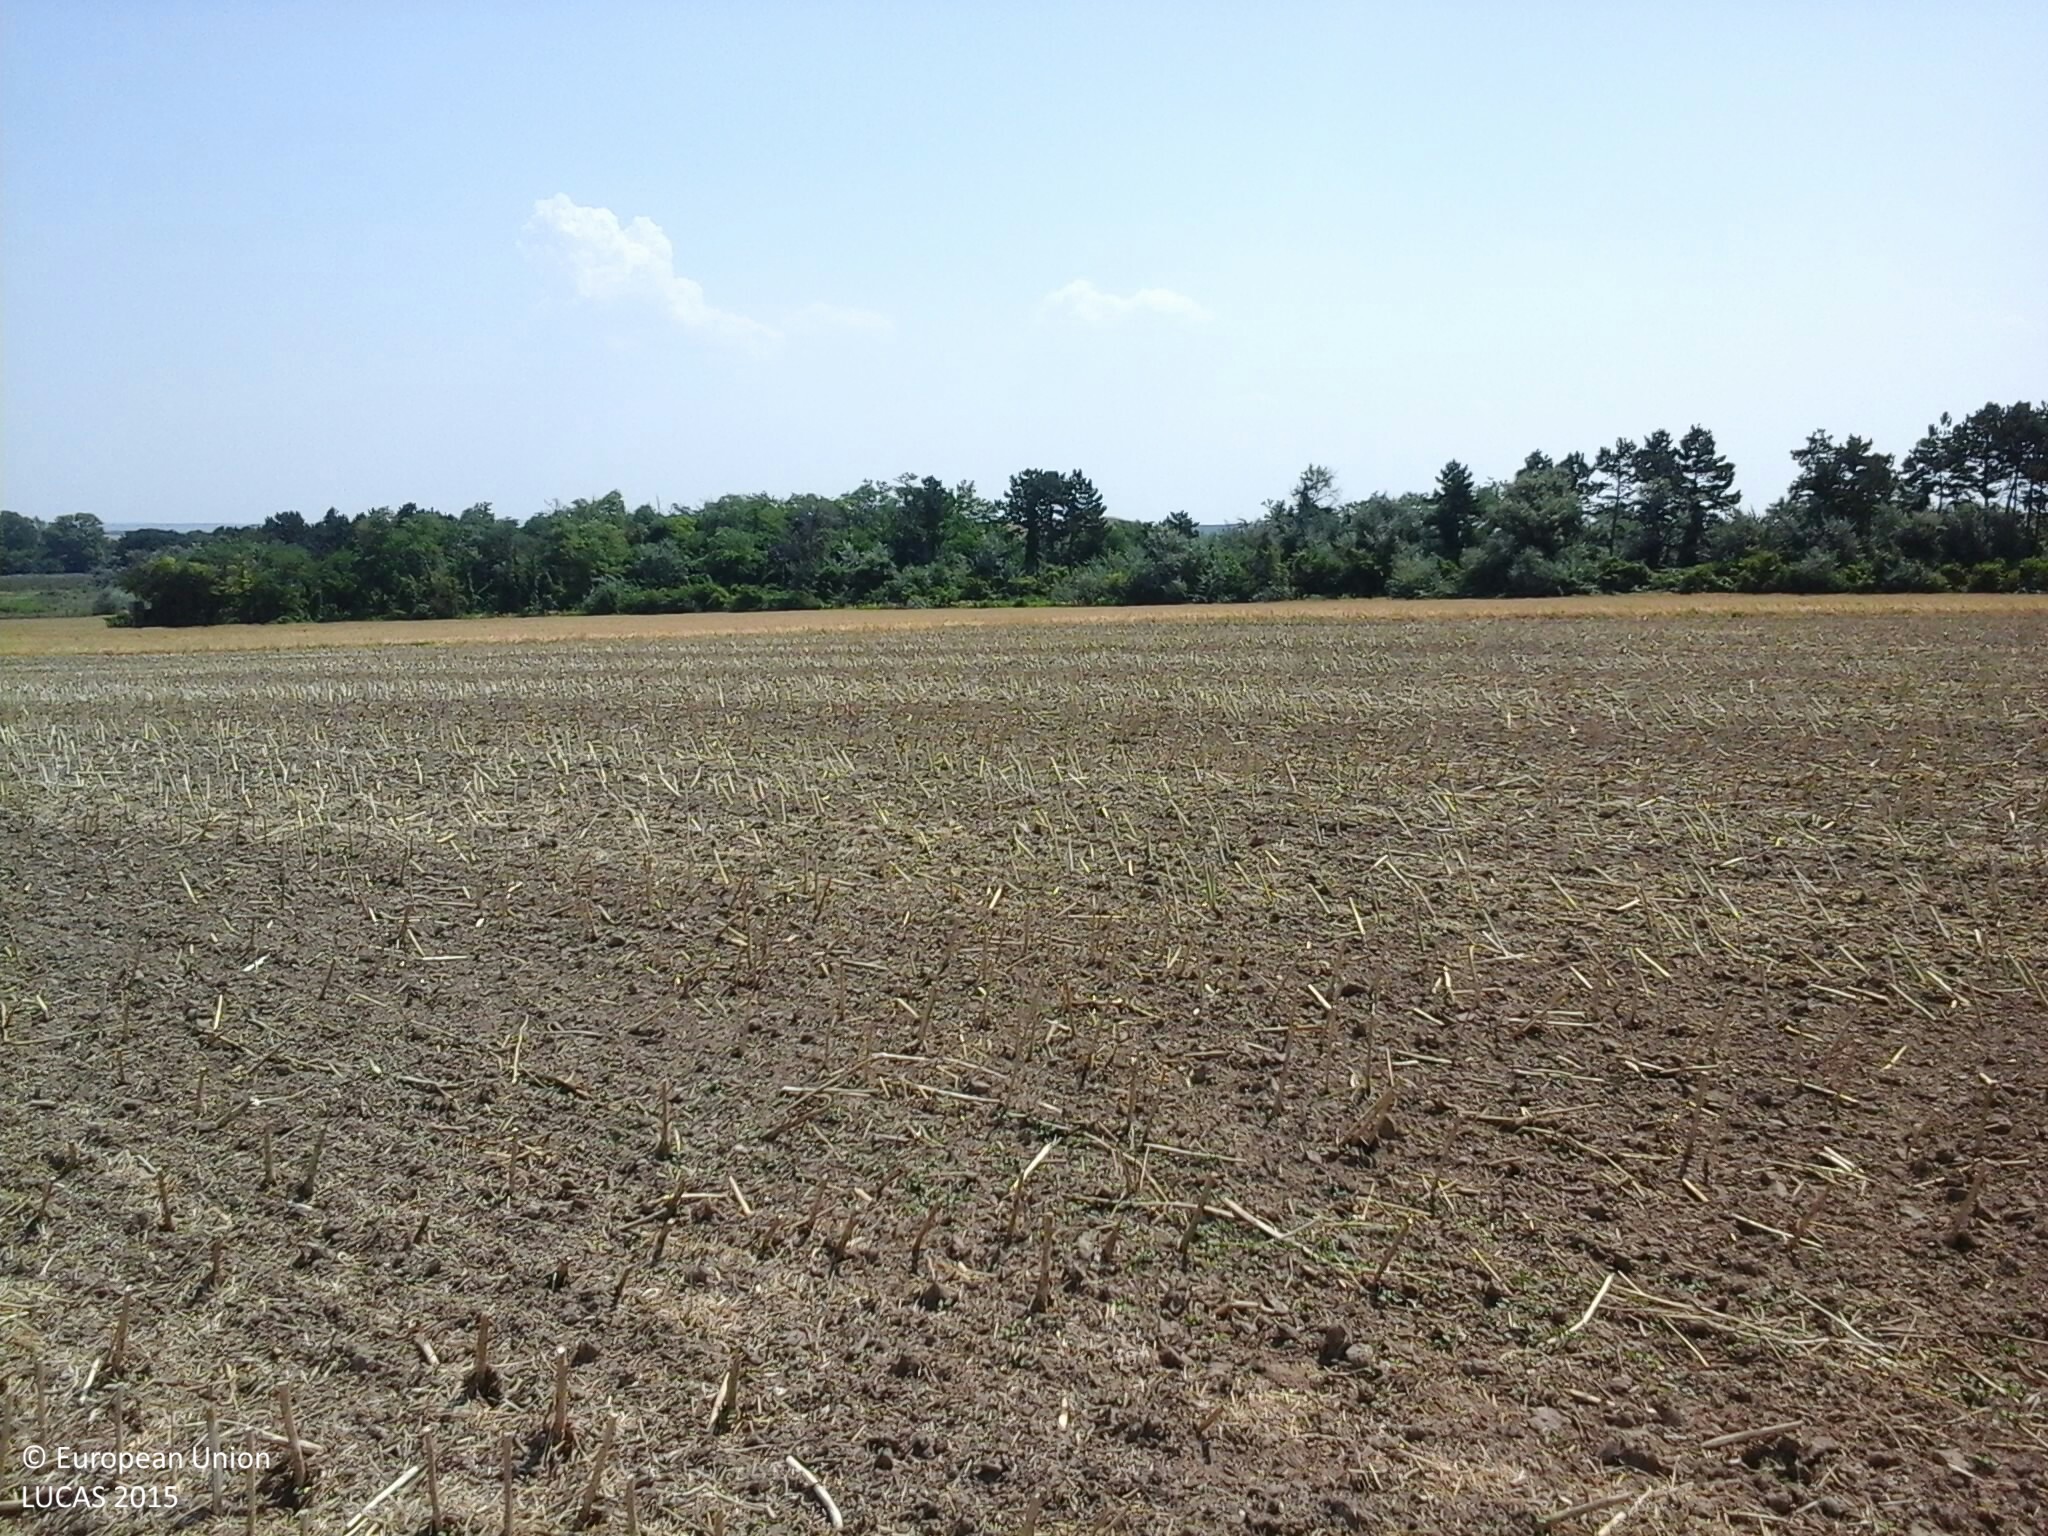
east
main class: Cropland
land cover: Rape and turnip rape
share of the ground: 10 - 25 %
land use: Agriculture (excluding fallow land and kitchen gardens)
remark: Harvested field
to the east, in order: Rape and turnip rape; Oats
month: July
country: HU
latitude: 47.3306
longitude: 18.3090
